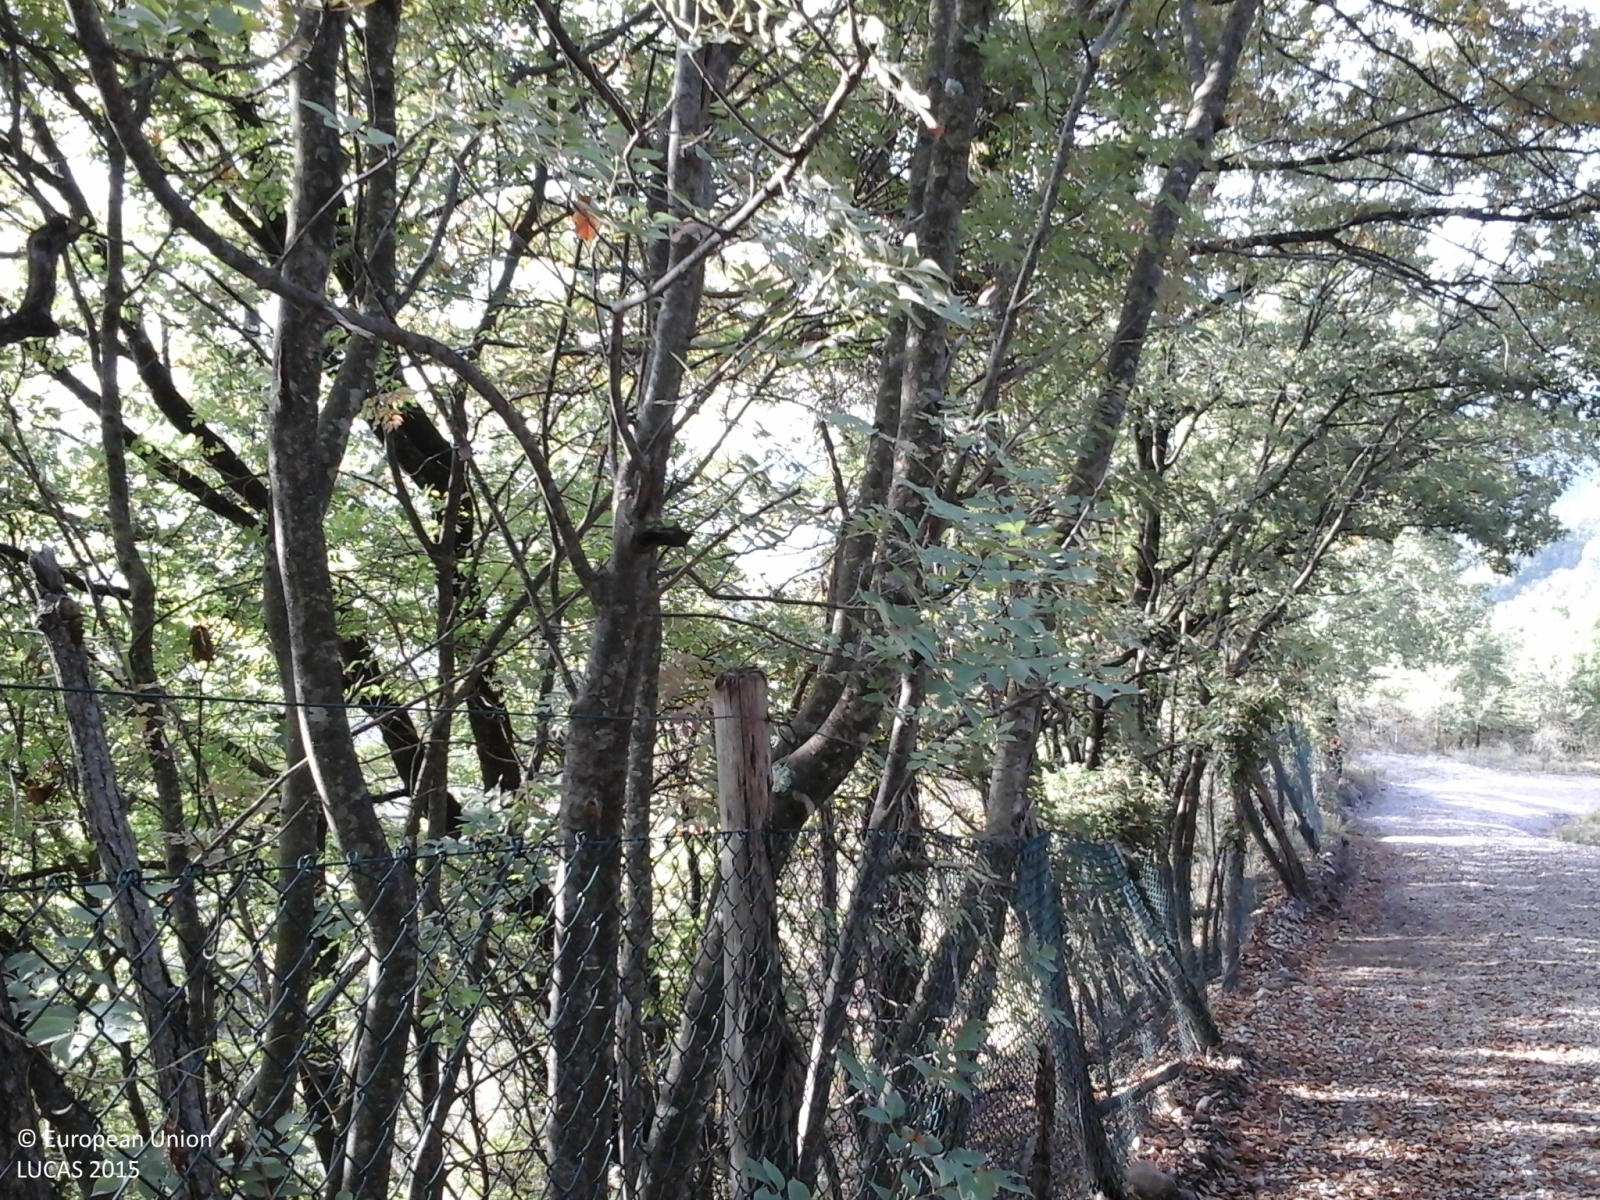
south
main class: Woodland
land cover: Broadleaved woodland
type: thermophilous deciduous forest
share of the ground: 50 - 75 %
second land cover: Grassland without tree/shrub cover
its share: > 75 %
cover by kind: broadleaved forest trees 60 %, herbaceous plants 40 %
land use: Forestry
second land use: Agriculture (excluding fallow land and kitchen gardens)
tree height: > 5 m
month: October
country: IT
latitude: 43.2531
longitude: 12.5918
